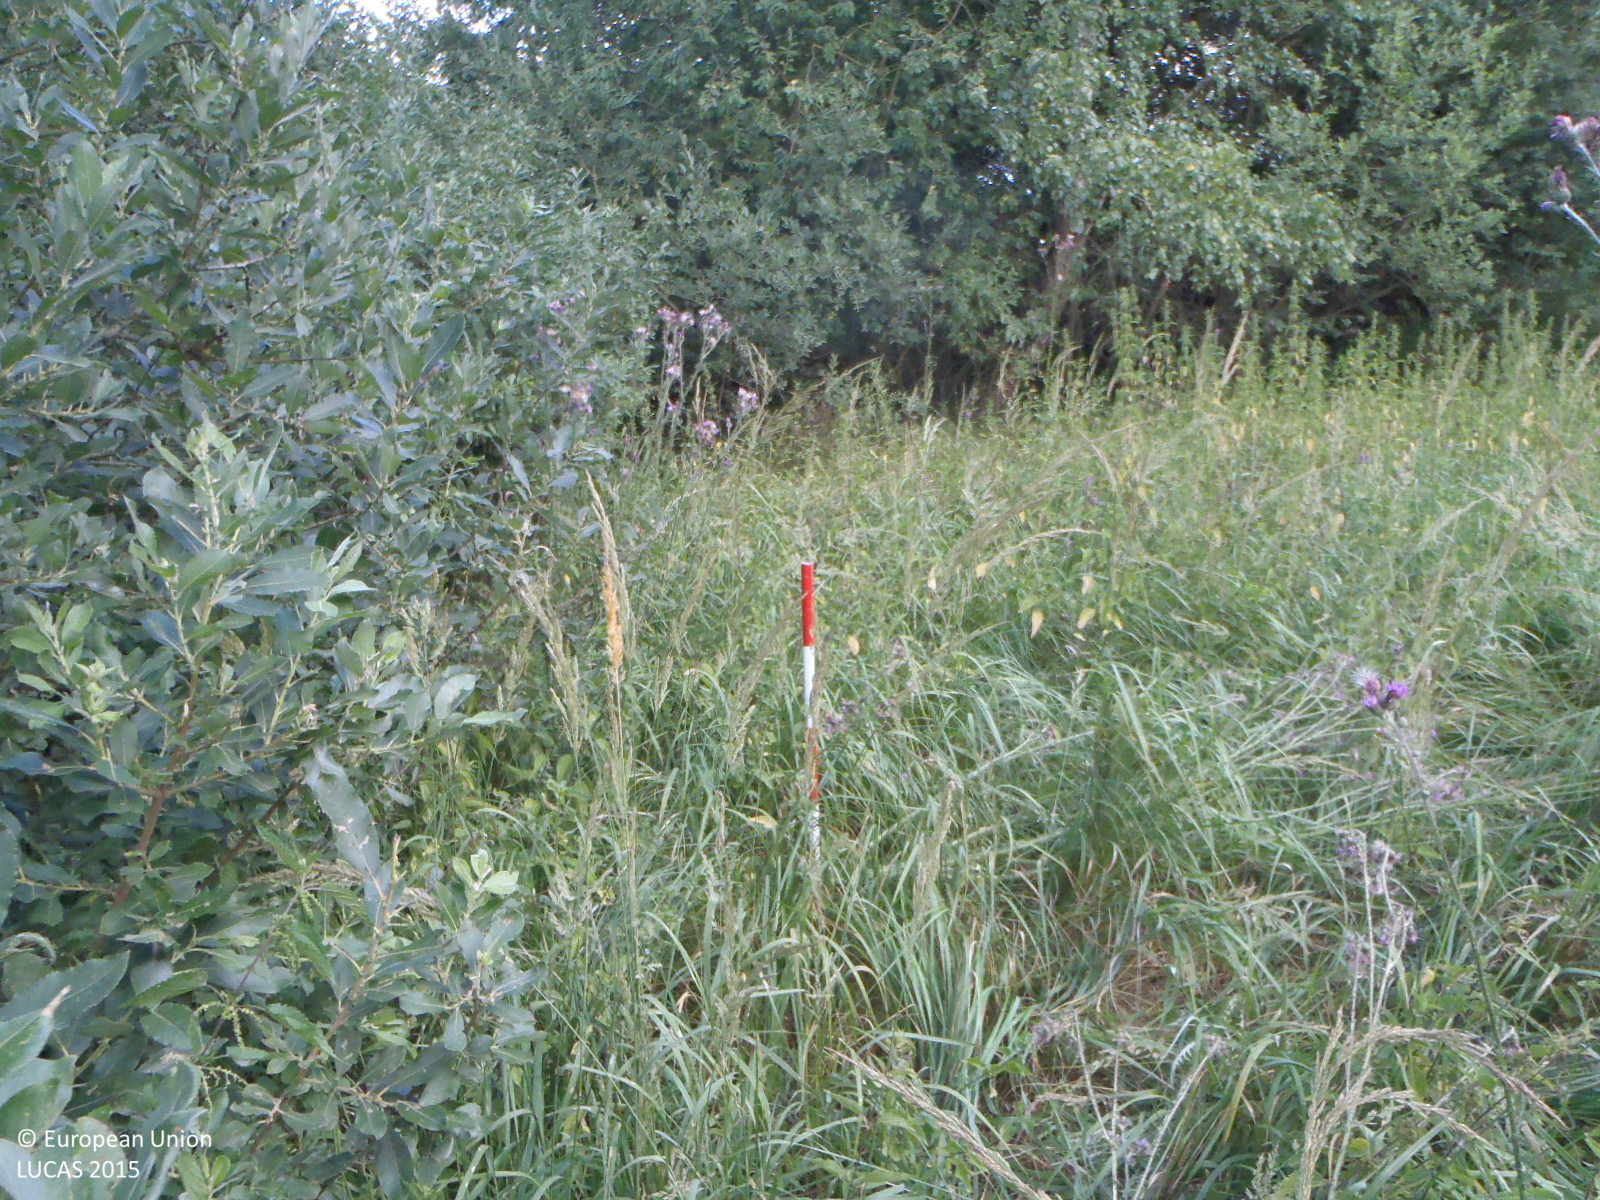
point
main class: Woodland
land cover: Broadleaved woodland
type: non-riverine alder, birch or aspen forest
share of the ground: > 75 %
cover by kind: broadleaved forest trees 100 %
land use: Semi-natural and natural areas not in use
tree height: > 5 m
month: July
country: CZ
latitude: 48.9662
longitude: 14.3583
